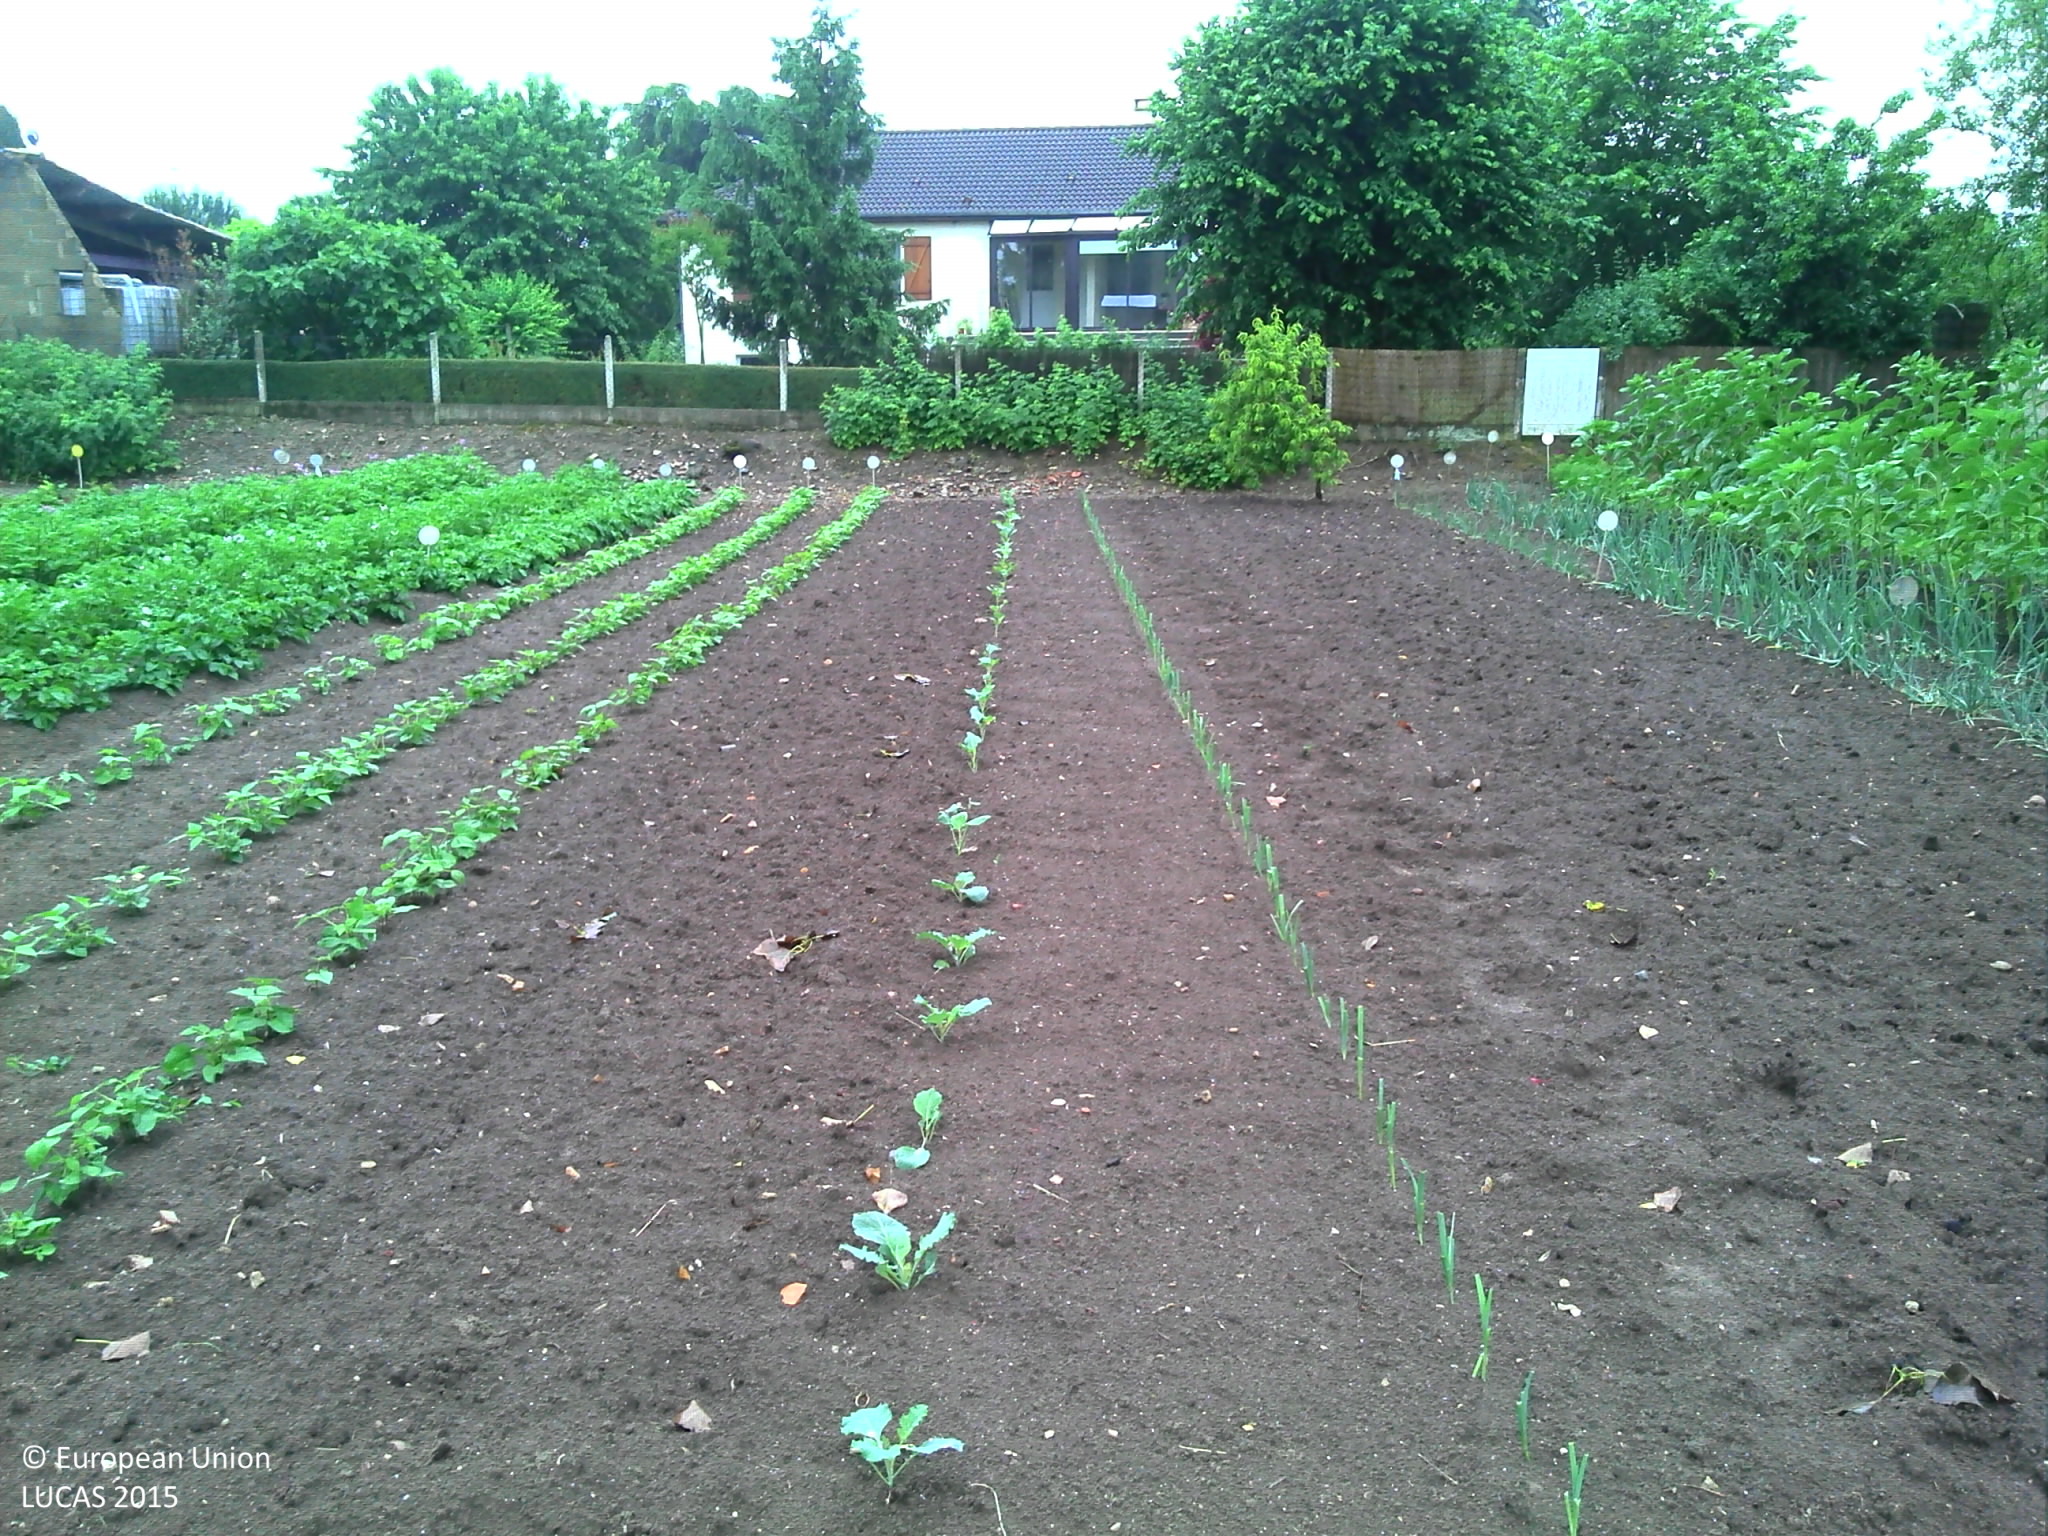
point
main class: Cropland
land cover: Other fresh vegetables
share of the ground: < 10 %
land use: Kitchen garden
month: June
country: FR
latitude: 46.7201
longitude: 0.4436
